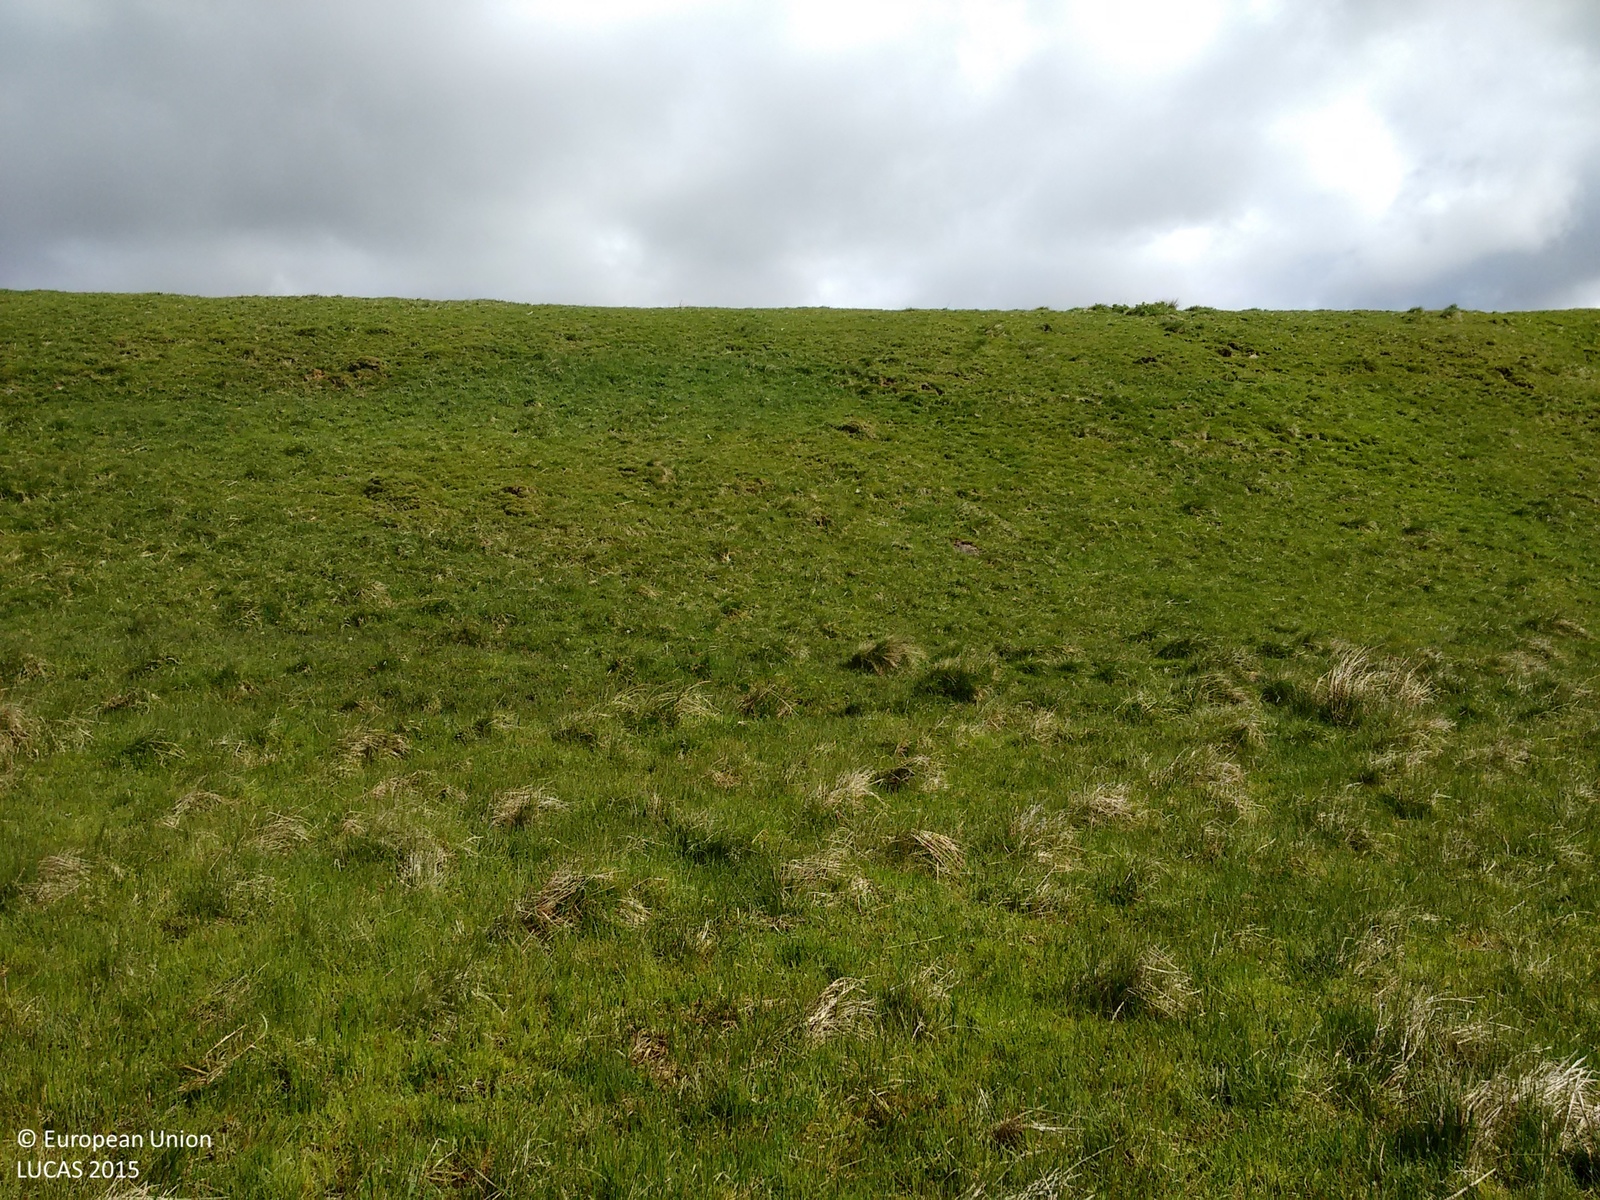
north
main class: Grassland
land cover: Grassland without tree/shrub cover
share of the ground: > 75 %
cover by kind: herbaceous plants 100 %
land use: Agriculture (excluding fallow land and kitchen gardens)
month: May
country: GB
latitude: 55.3497
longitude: -2.1840
